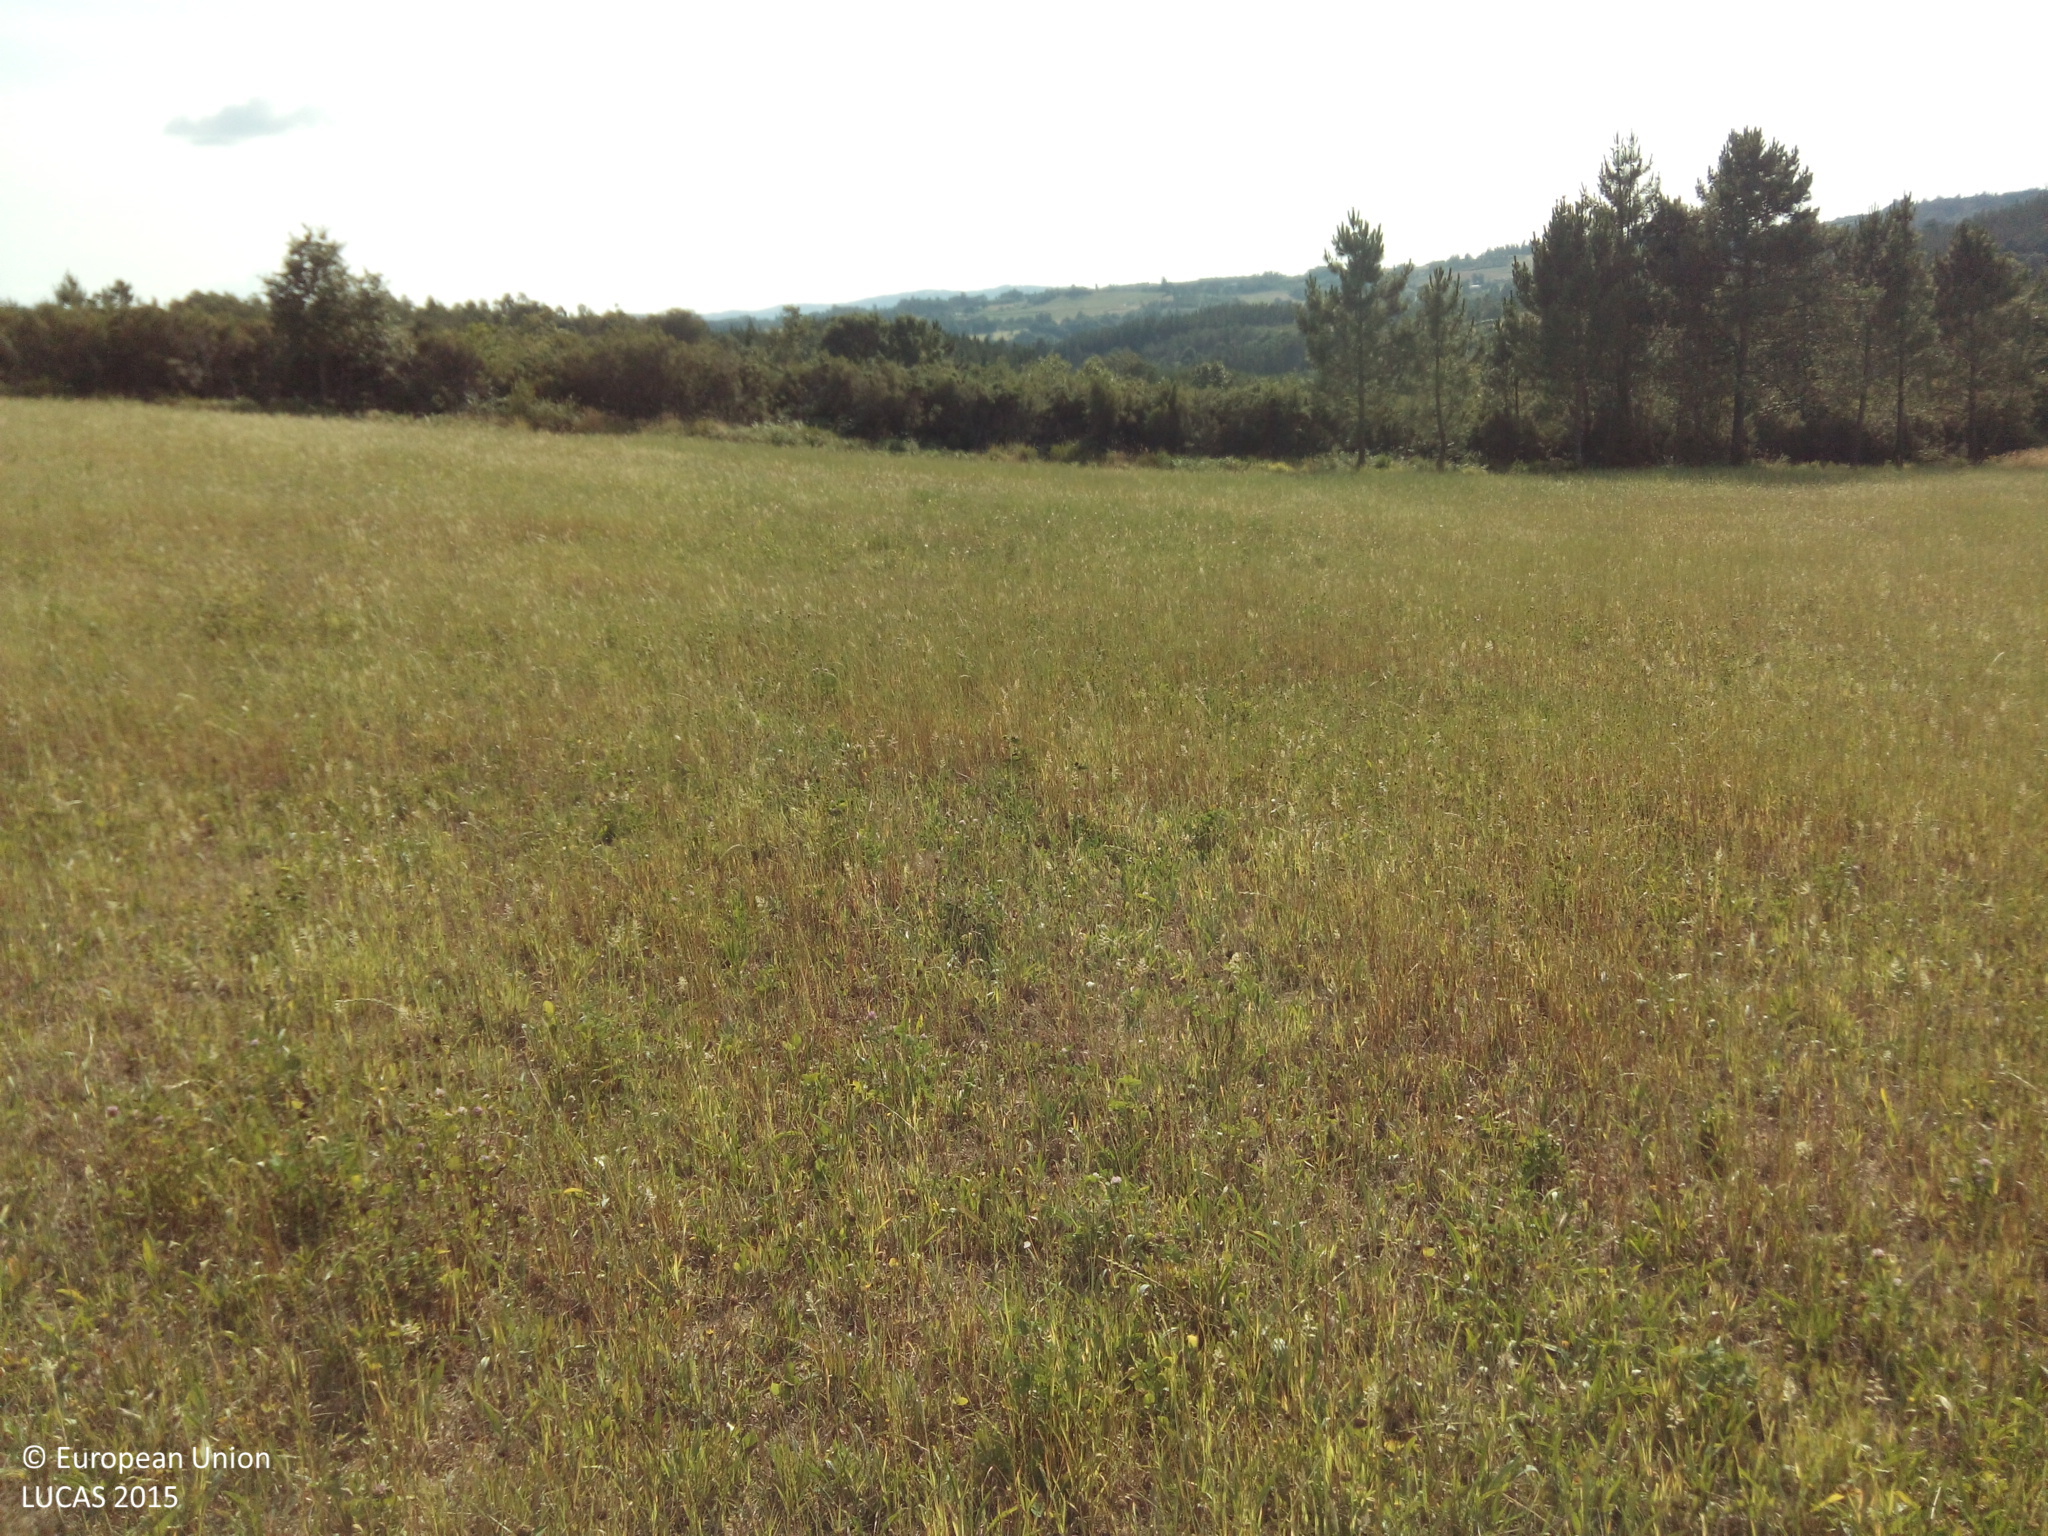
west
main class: Cropland
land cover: Mixed cereals for fodder
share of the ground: > 75 %
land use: Agriculture (excluding fallow land and kitchen gardens)
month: July
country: ES
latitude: 42.8717
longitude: -7.9971
